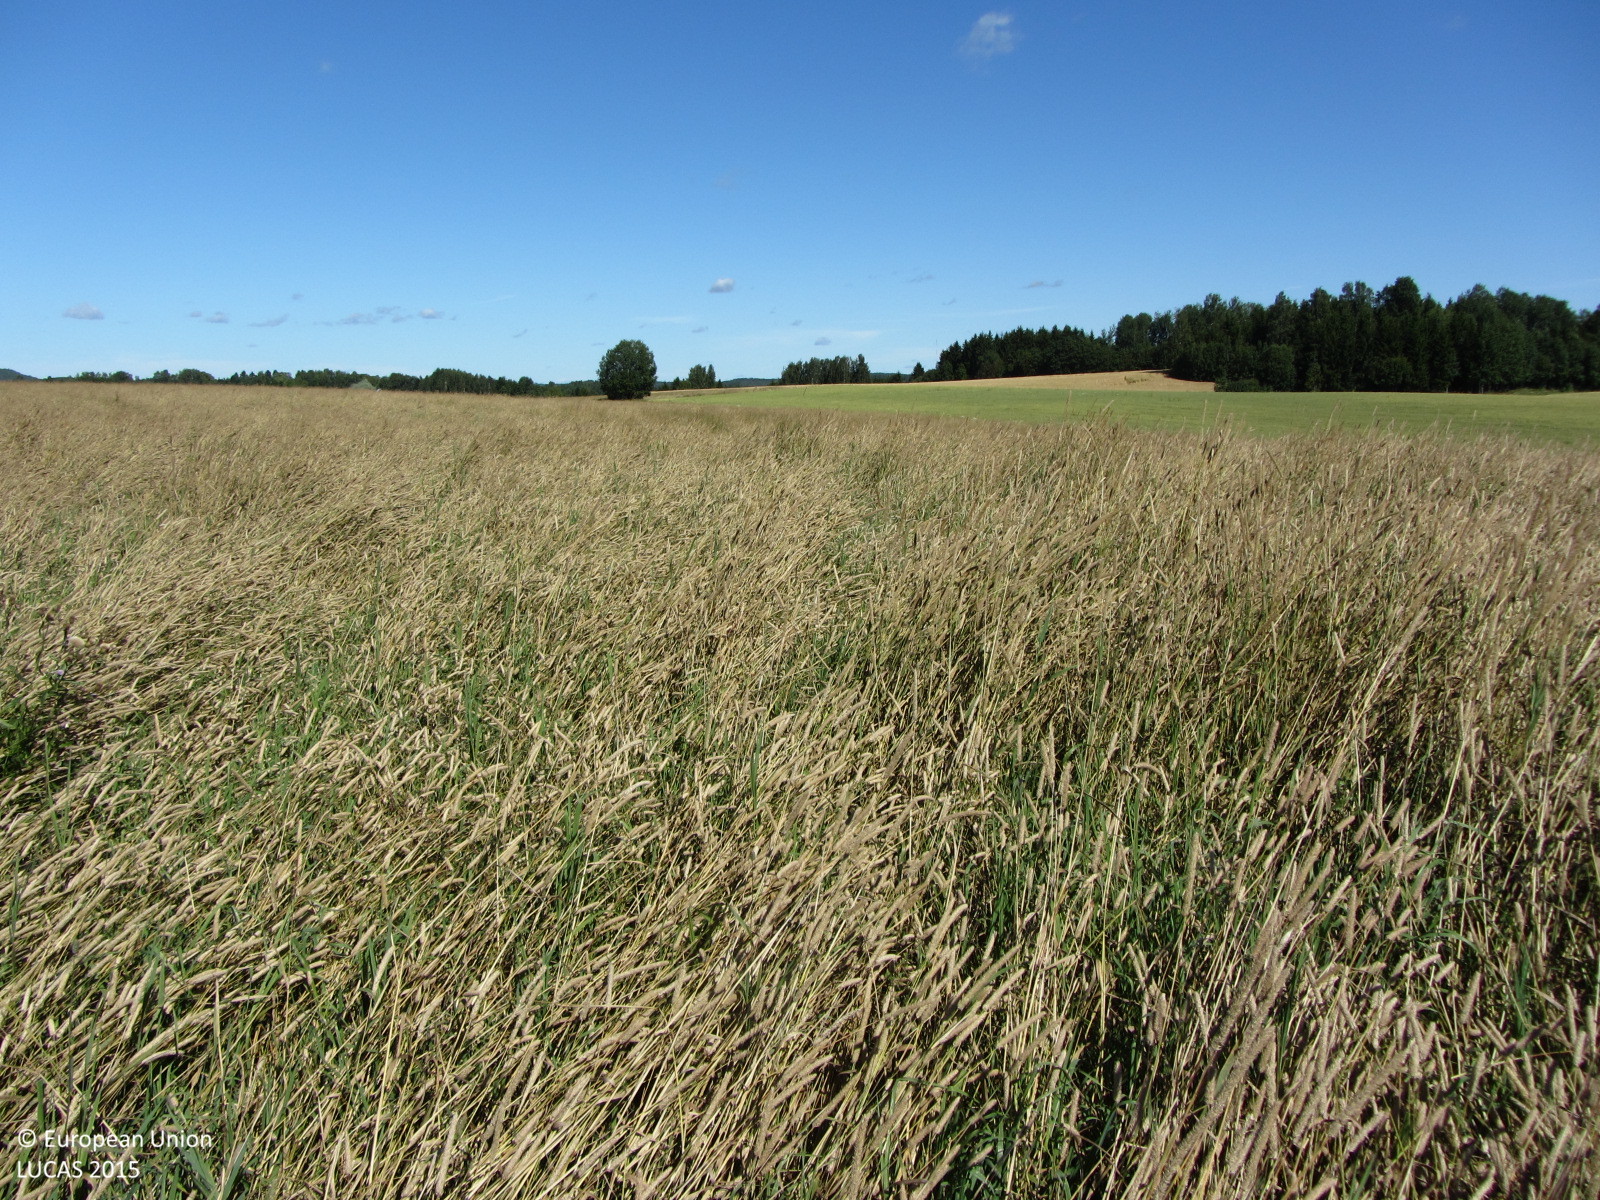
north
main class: Grassland
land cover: Spontaneously vegetated surfaces
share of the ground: > 75 %
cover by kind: herbaceous plants 100 %
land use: Fallow land
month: August
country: FI
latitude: 60.4524
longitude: 23.9663
